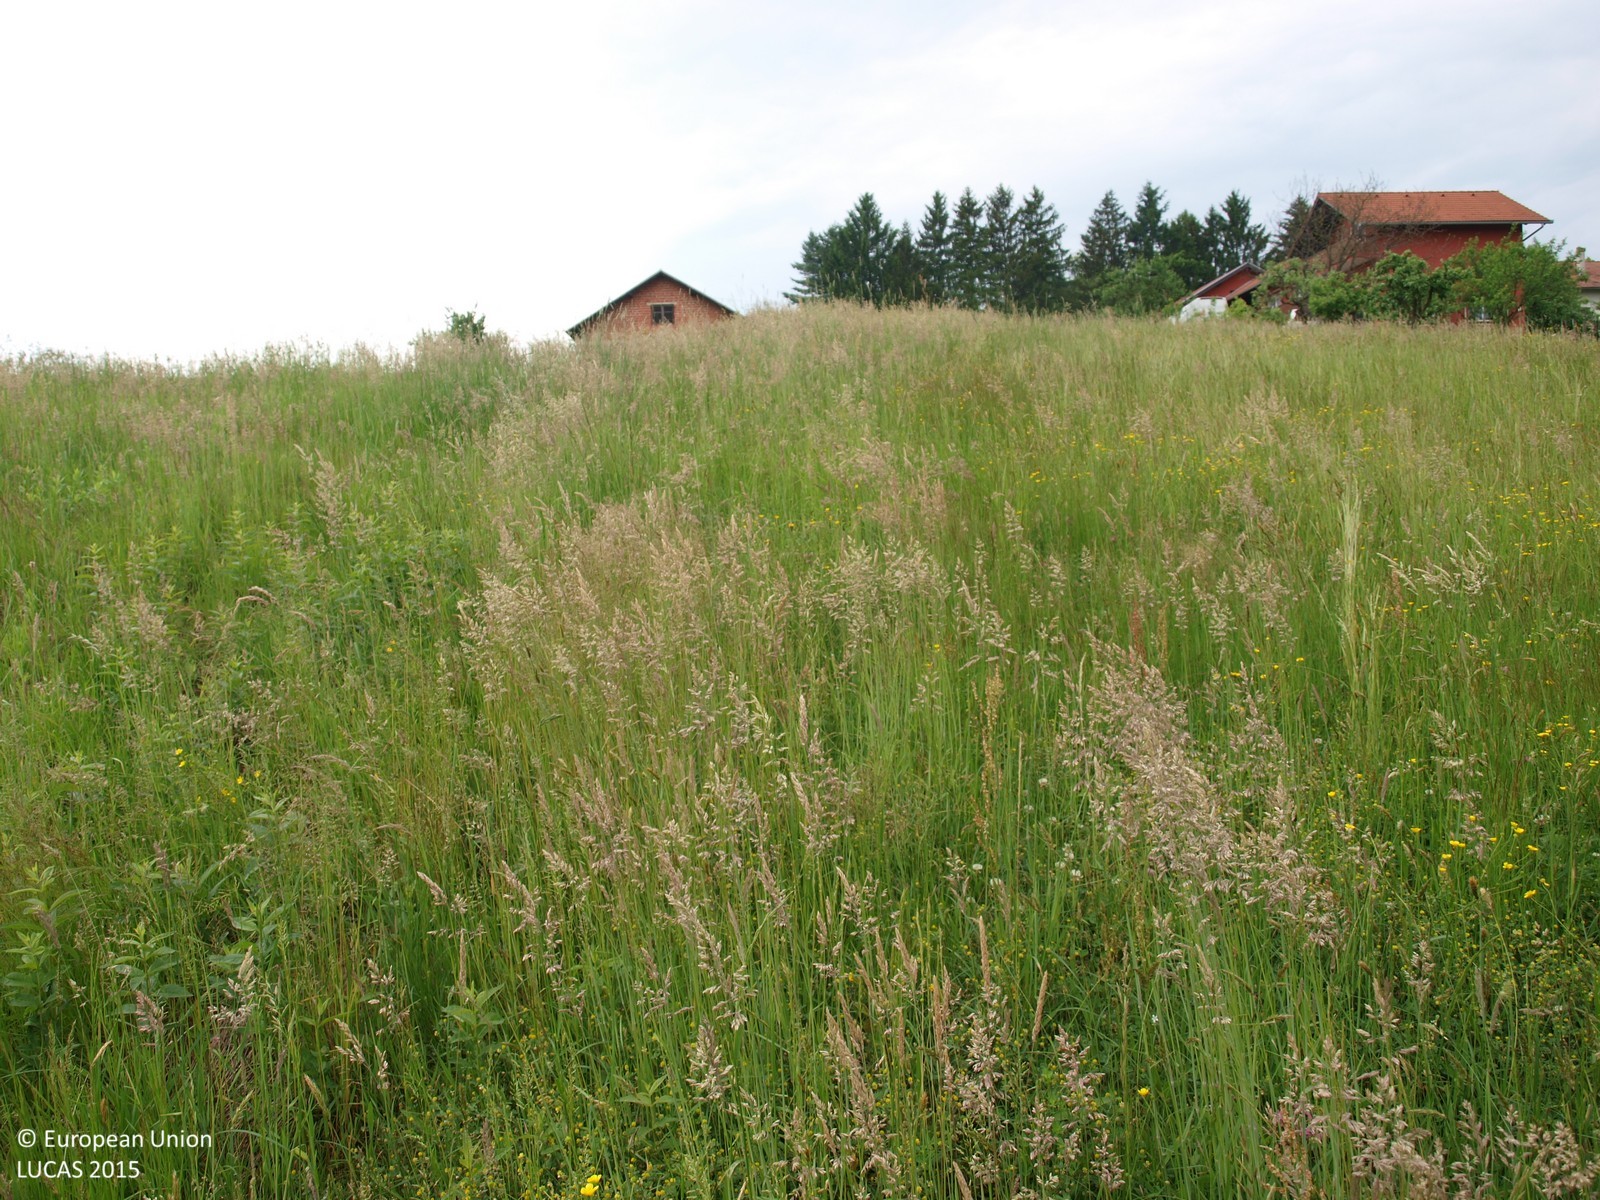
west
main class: Grassland
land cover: Grassland without tree/shrub cover
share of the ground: > 75 %
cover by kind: herbaceous plants 100 %
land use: Agriculture (excluding fallow land and kitchen gardens)
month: May
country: HR
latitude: 46.0650
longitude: 16.1655
